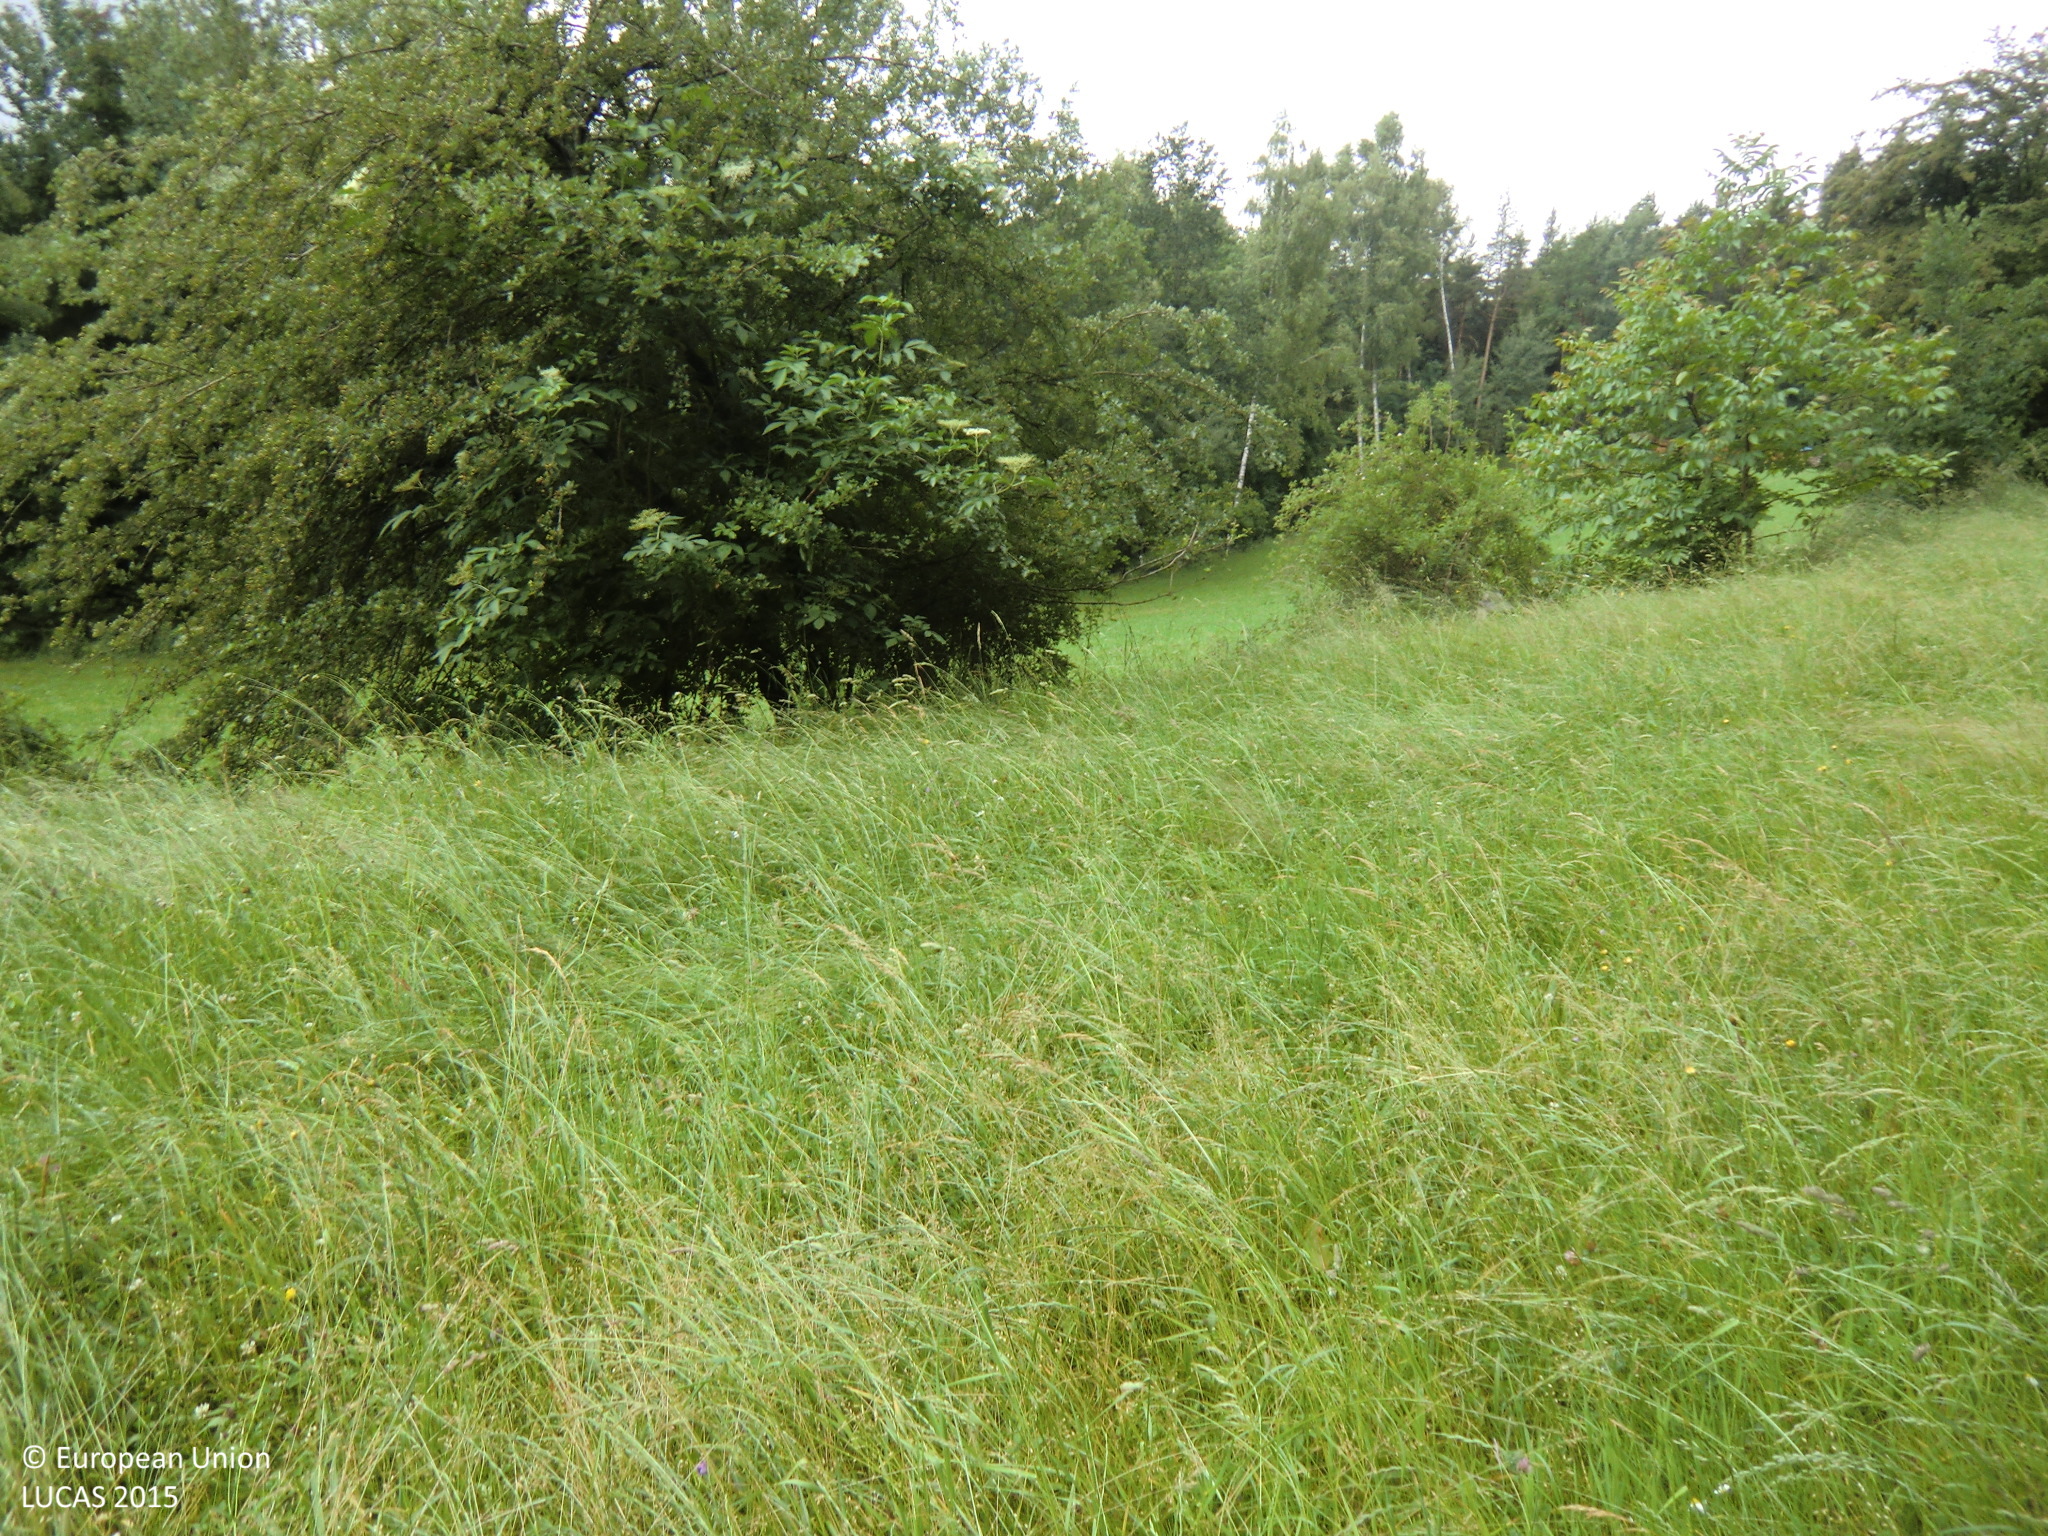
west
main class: Grassland
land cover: Grassland without tree/shrub cover
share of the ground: > 75 %
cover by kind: herbaceous plants 90 %, unconsolidated bare surface 10 %
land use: Agriculture (excluding fallow land and kitchen gardens)
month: June
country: AT
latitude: 48.5076
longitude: 14.5623
